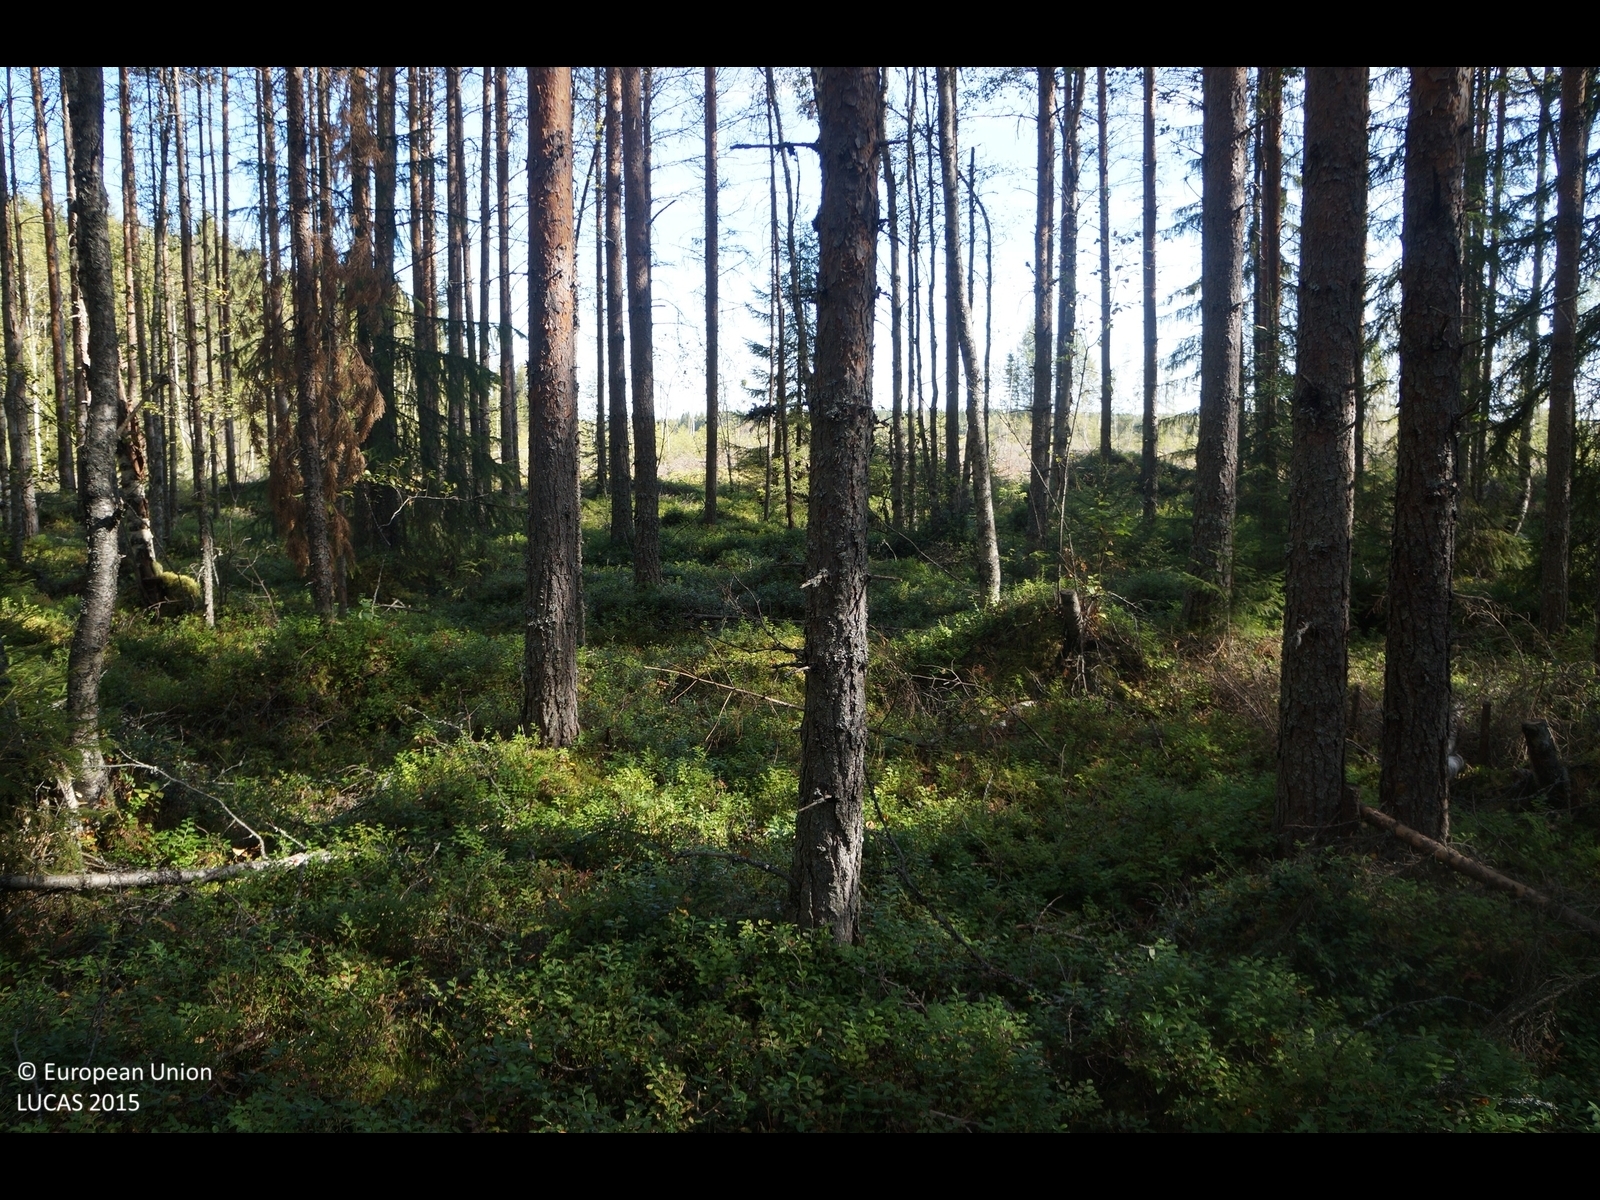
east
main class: Woodland
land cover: Pine dominated mixed woodland
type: boreal forest
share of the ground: 50 - 75 %
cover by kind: coniferous forest trees 50 %, broadleaved forest trees 20 %, shrubs 20 %, lichens and mosses 10 %
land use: Forestry
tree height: > 5 m
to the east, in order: Pine dominated mixed woodland; Ditches and canals; Shrubland with sparse tree cover; Ditches and canals; Shrubland with sparse tree cover; Ditches and canals; Shrubland with sparse tree cover
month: September
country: FI
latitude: 63.8967
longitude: 24.0623
